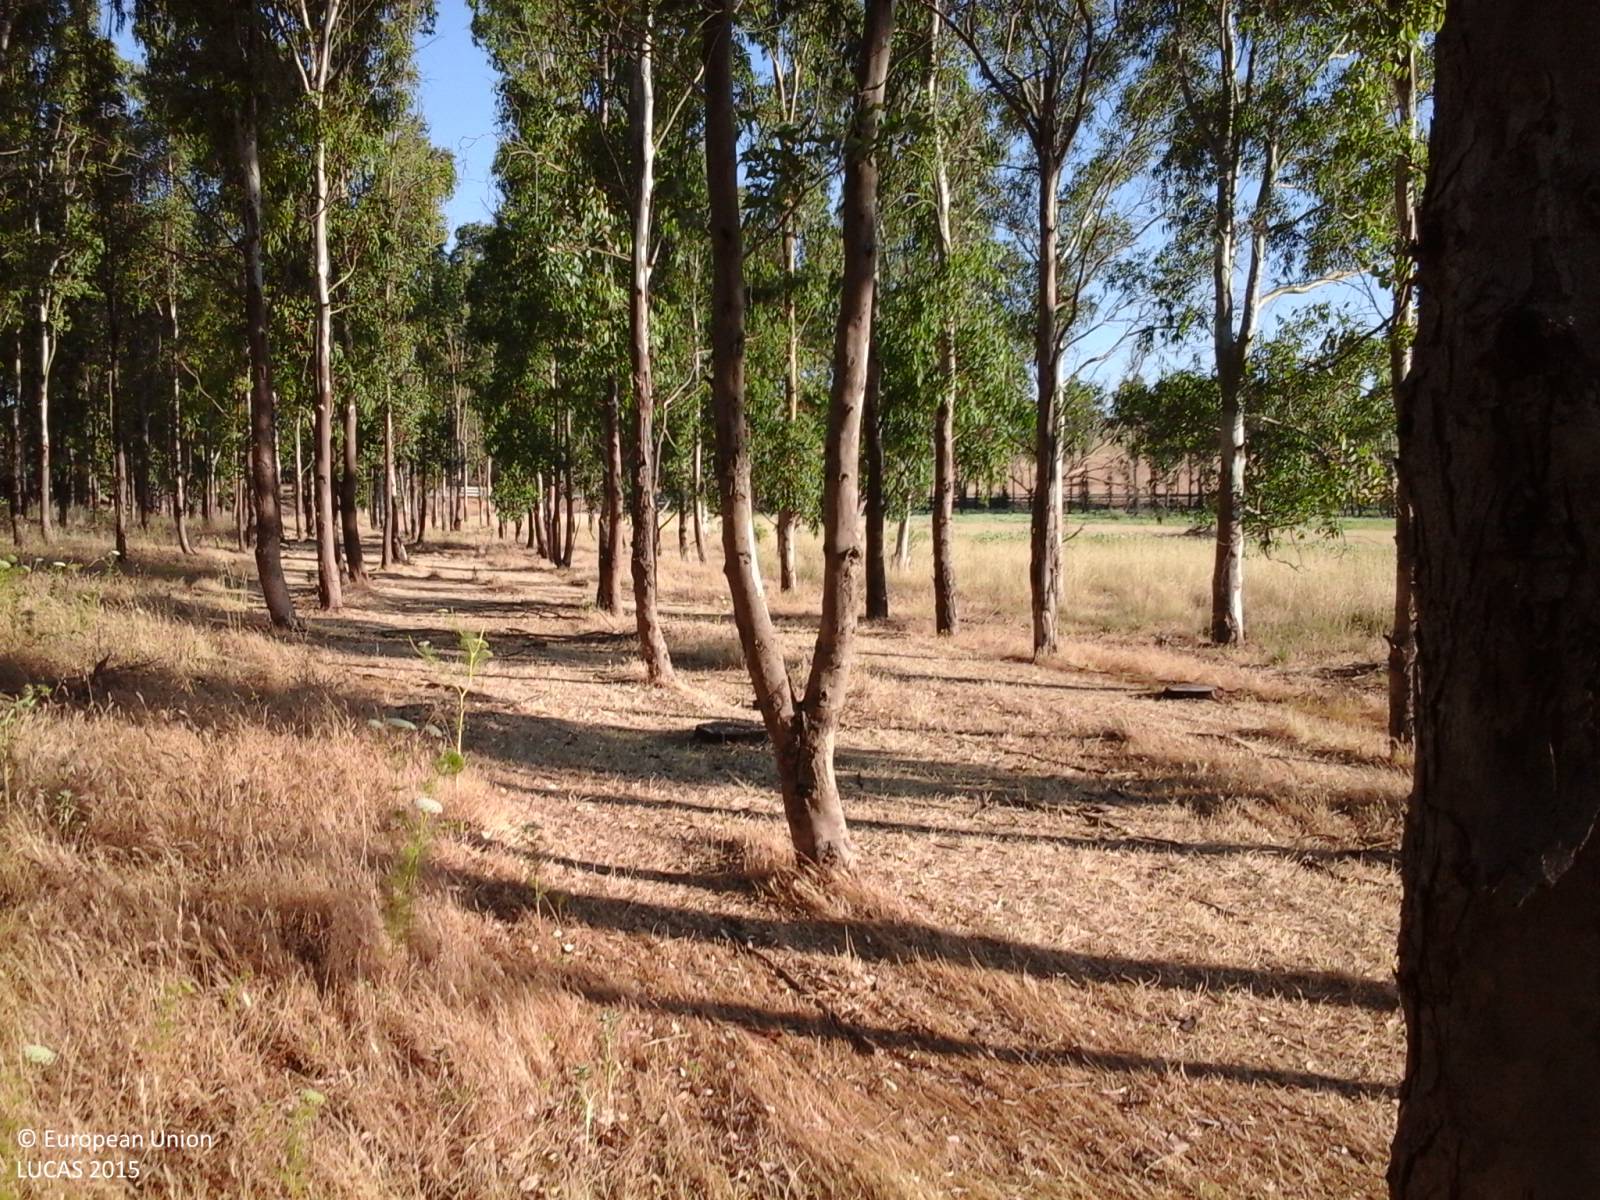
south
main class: Woodland
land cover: Broadleaved woodland
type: broadleaved evergreen forest
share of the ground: 25 - 50 %
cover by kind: broadleaved forest trees 50 %, herbaceous plants 50 %
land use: Forestry
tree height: > 5 m
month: June
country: IT
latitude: 37.9666
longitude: 12.5878
